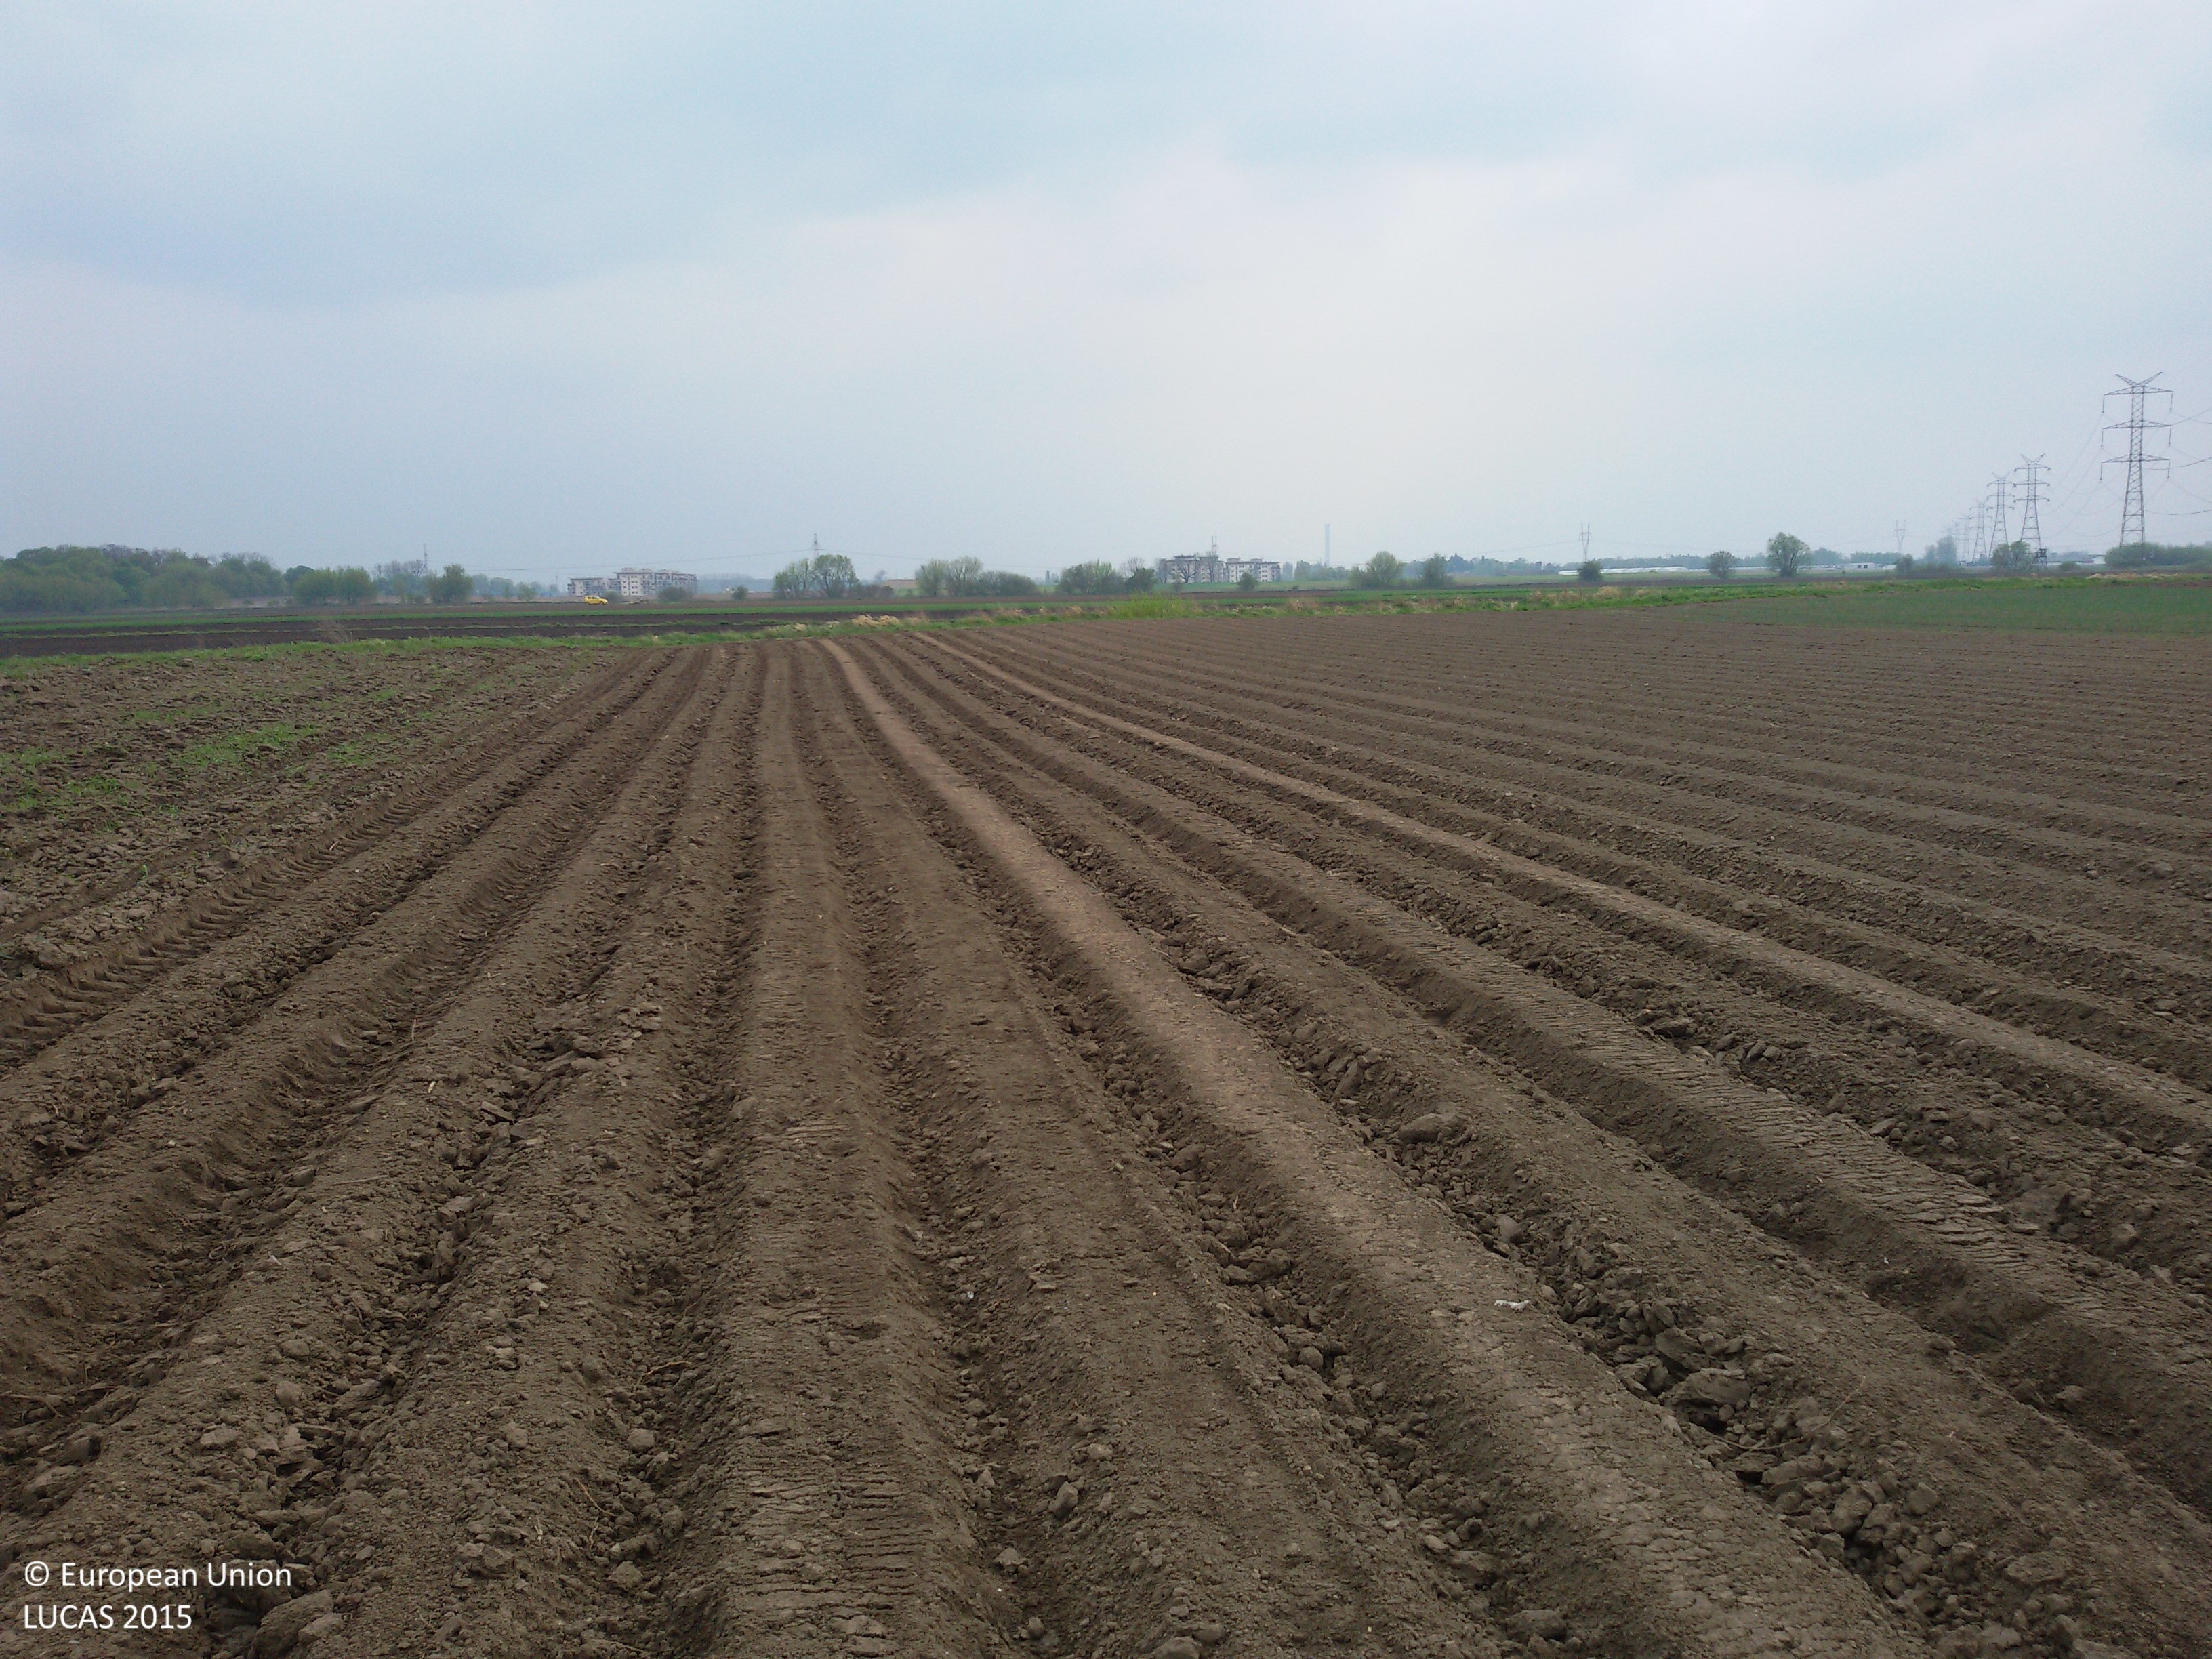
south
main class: Cropland
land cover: Potatoes
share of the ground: < 10 %
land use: Agriculture (excluding fallow land and kitchen gardens)
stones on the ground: < 10 %
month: May
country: PL
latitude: 52.2481
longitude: 20.7778
